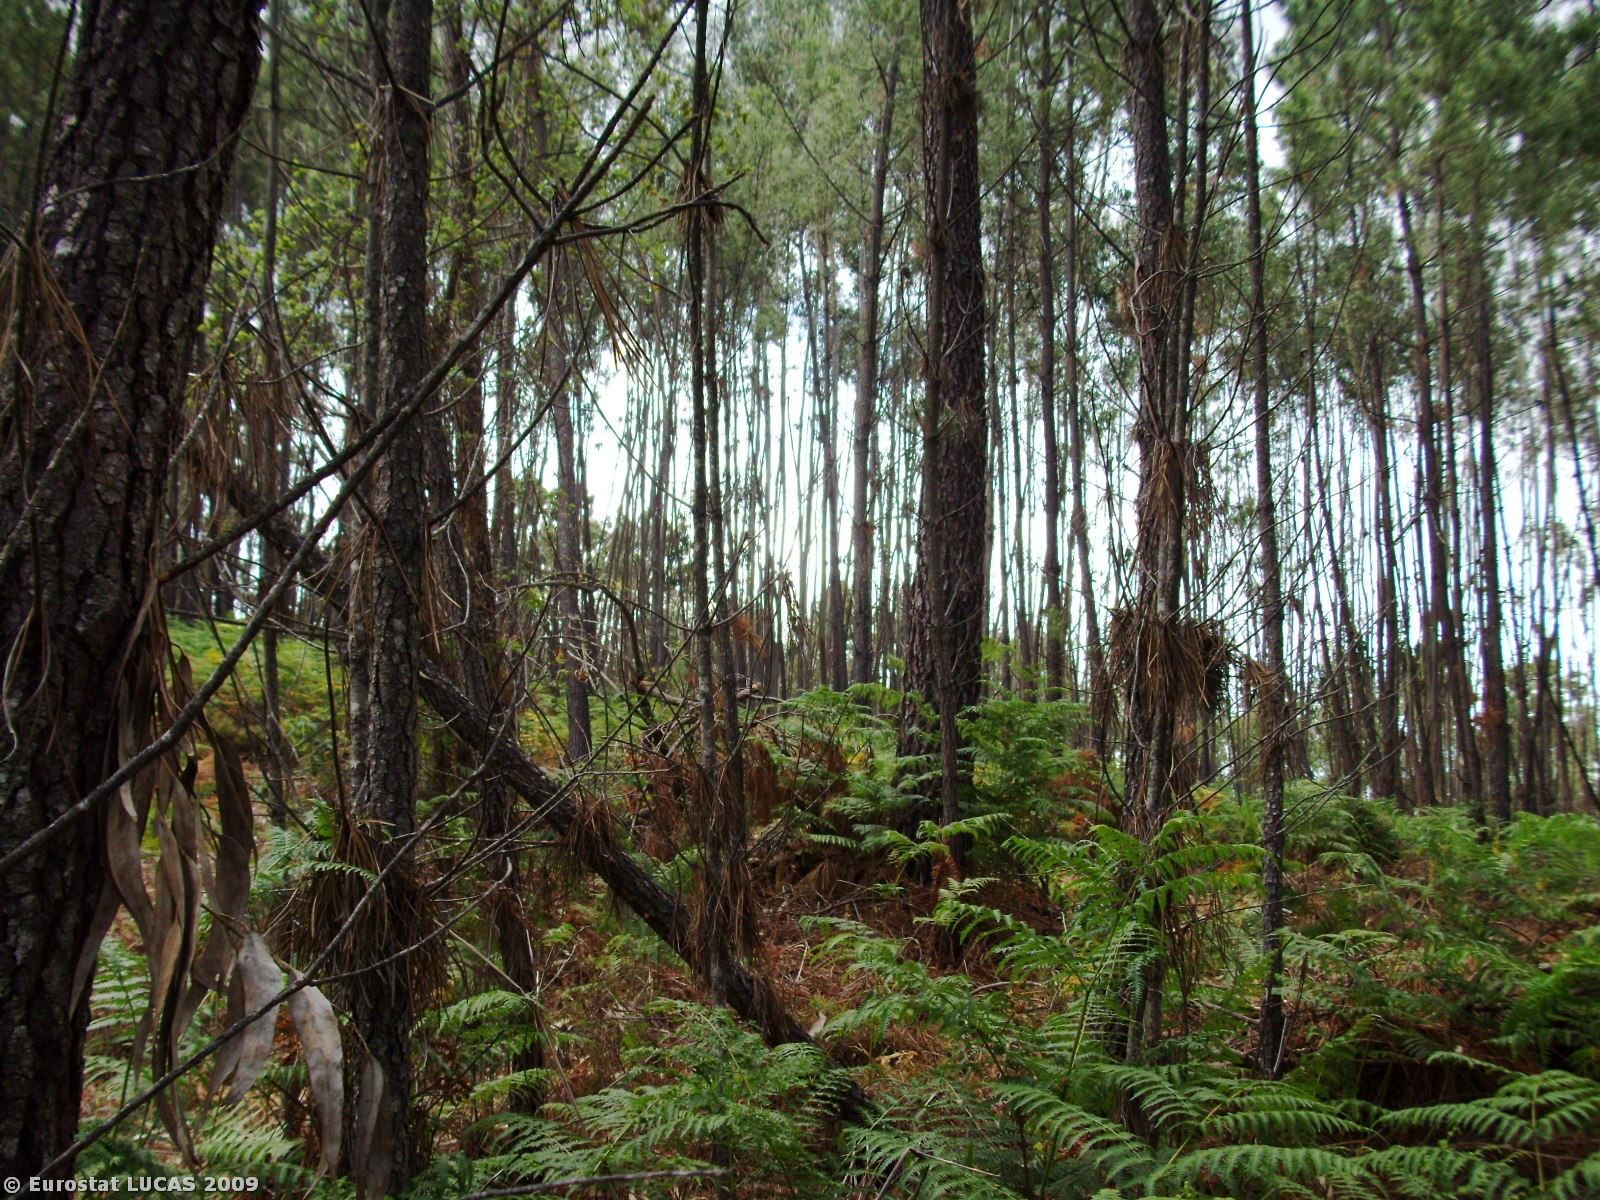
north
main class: Woodland
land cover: Coniferous woodland
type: coniferous forest of the mediterranean region
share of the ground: 50 - 75 %
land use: Forestry
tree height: > 5 m
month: June
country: PT
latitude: 39.9533
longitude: -8.3006
